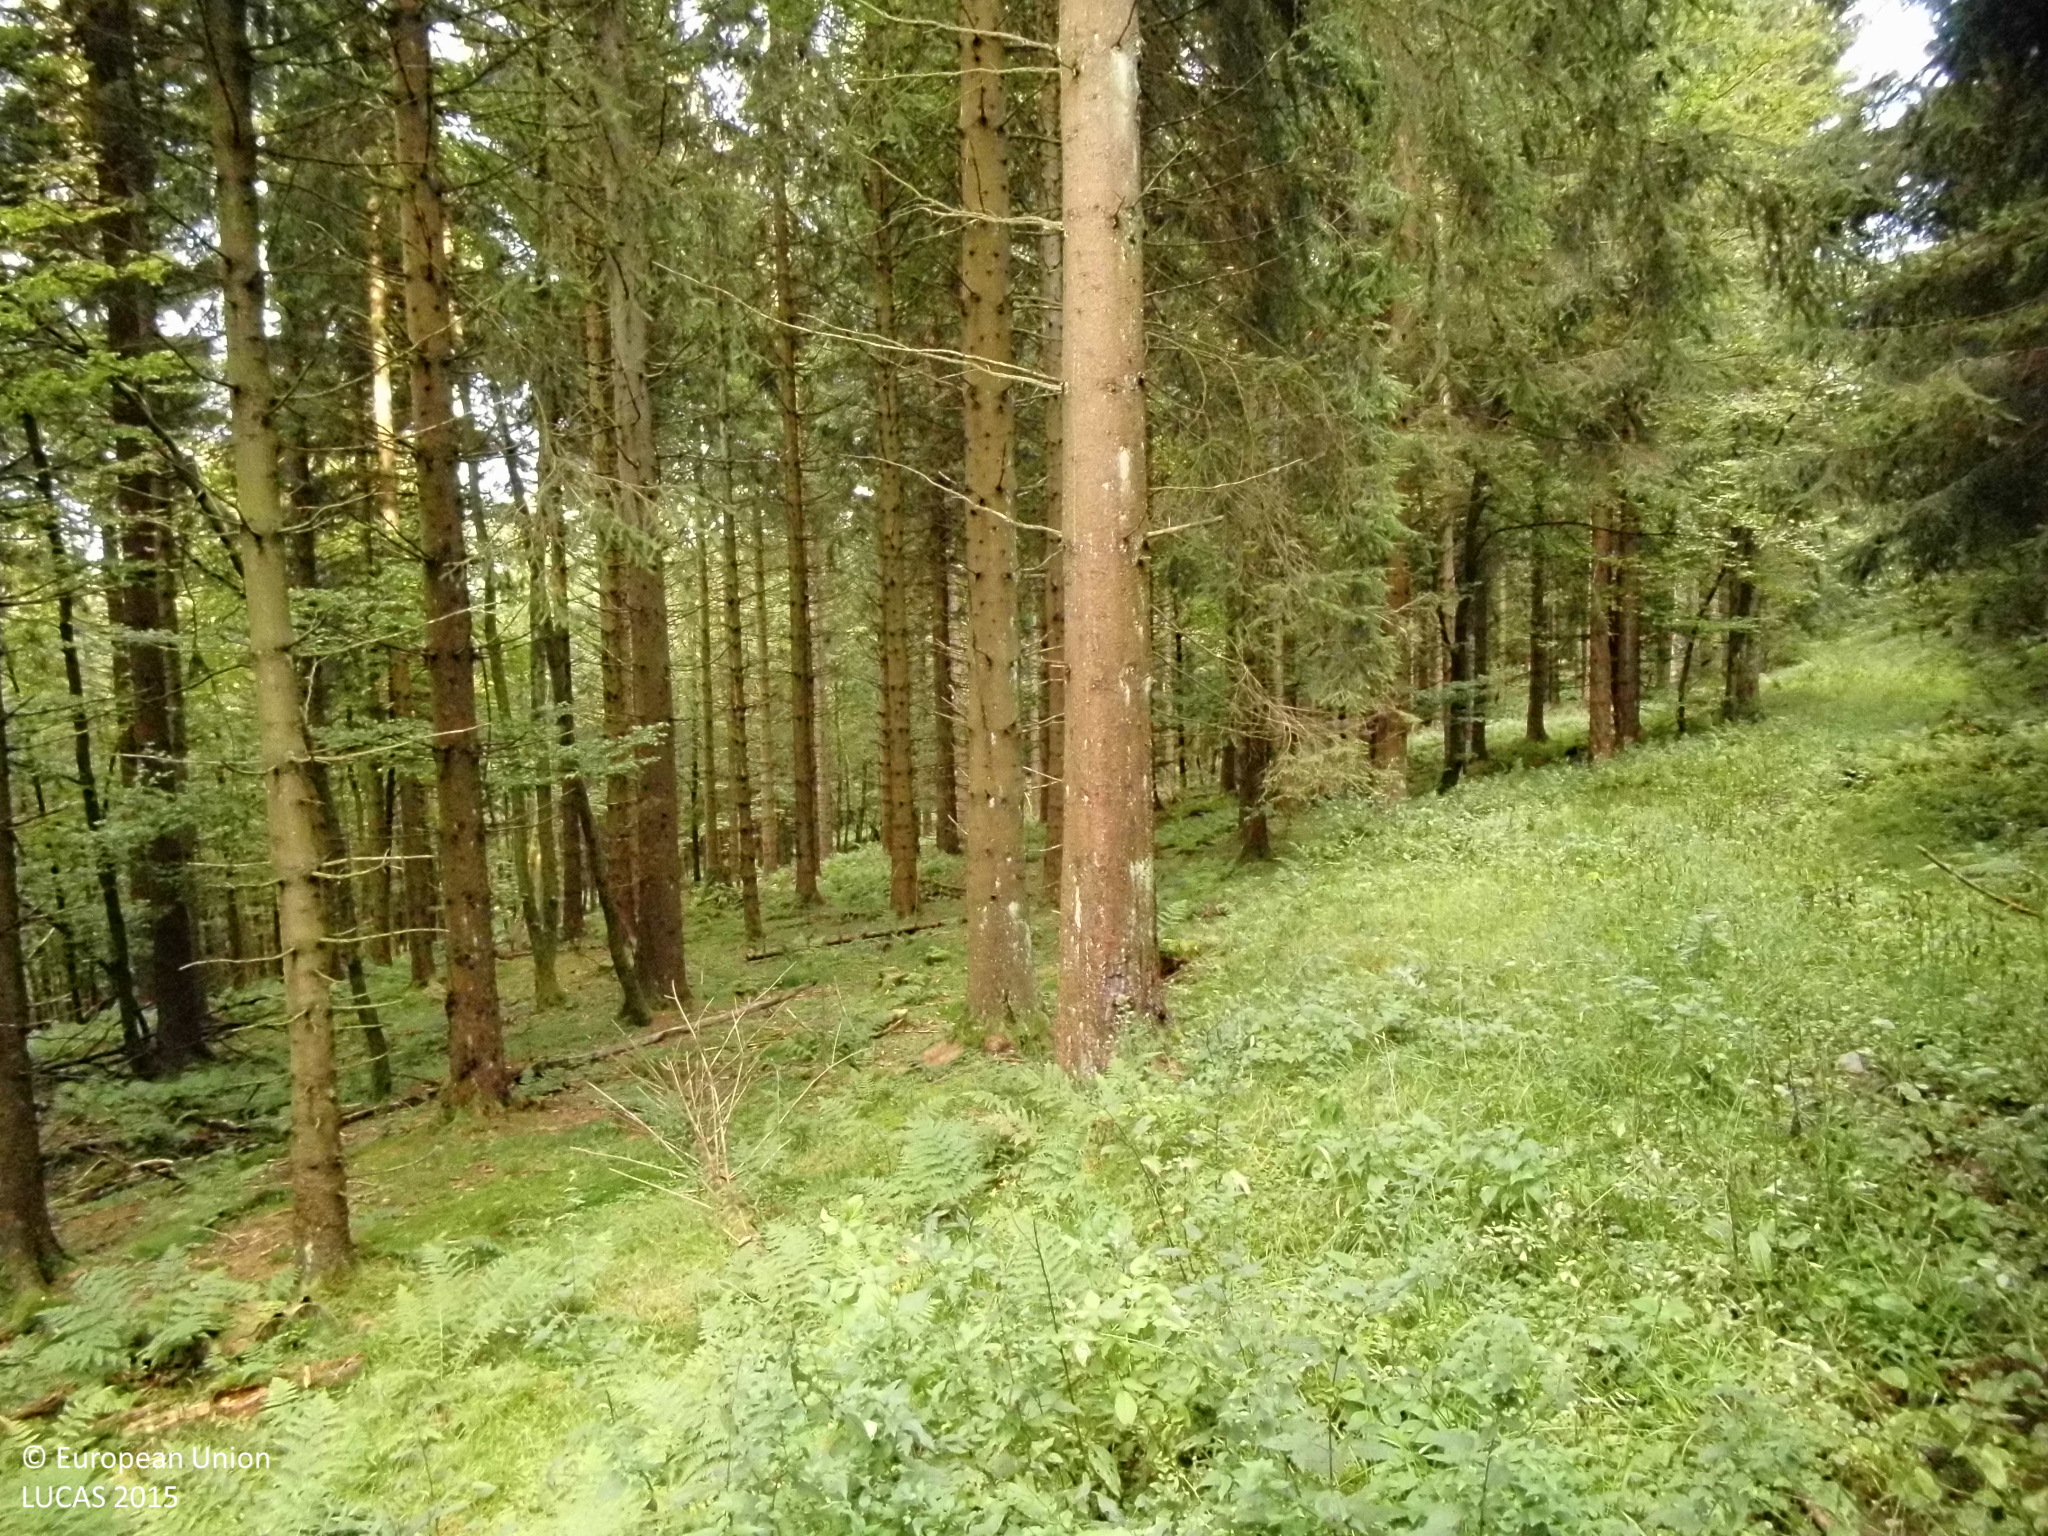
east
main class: Artificial land
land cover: Non built-up linear features
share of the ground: > 75 %
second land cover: Grassland without tree/shrub cover
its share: > 75 %
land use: Forestry
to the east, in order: Tracks; Spruce dominated coniferous woodland; Spruce dominated mixed woodland; Grass margins; Tracks; Grass margins; Spruce dominated coniferous woodland
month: September
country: DE
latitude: 51.1990
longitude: 8.4691
